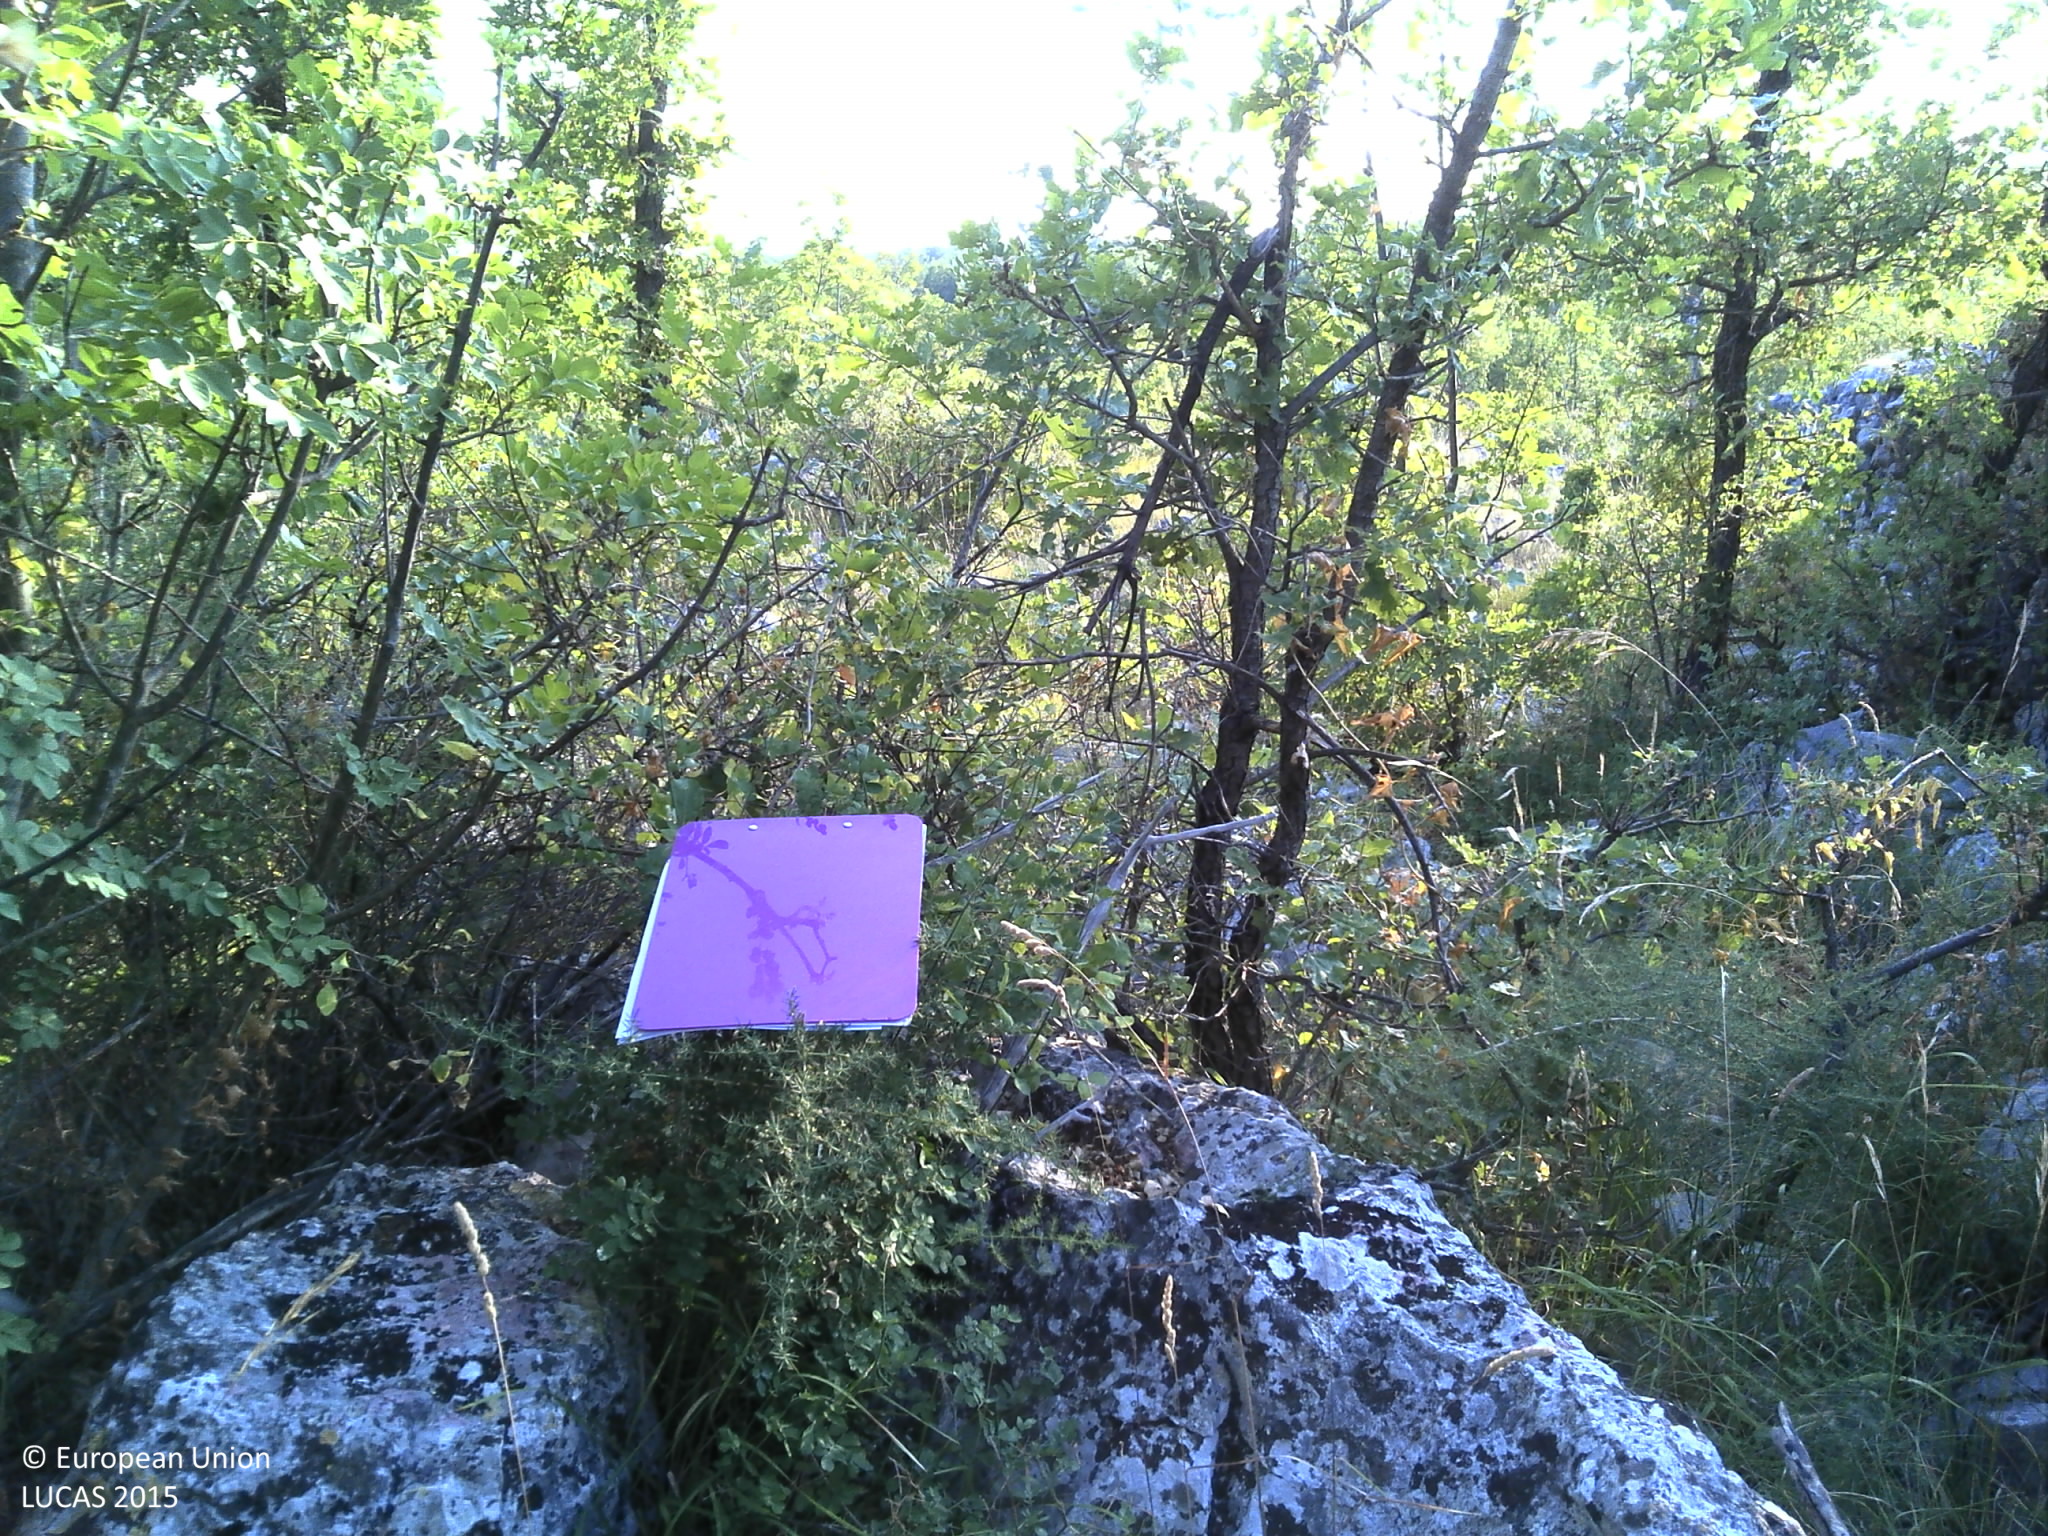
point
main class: Woodland
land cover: Broadleaved woodland
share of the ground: 10 - 25 %
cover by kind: shrubs 30 %, broadleaved forest trees 25 %, unconsolidated bare surface 25 %, herbaceous plants 20 %
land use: Semi-natural and natural areas not in use
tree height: > 5 m
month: July
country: HR
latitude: 43.8891
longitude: 16.2782
